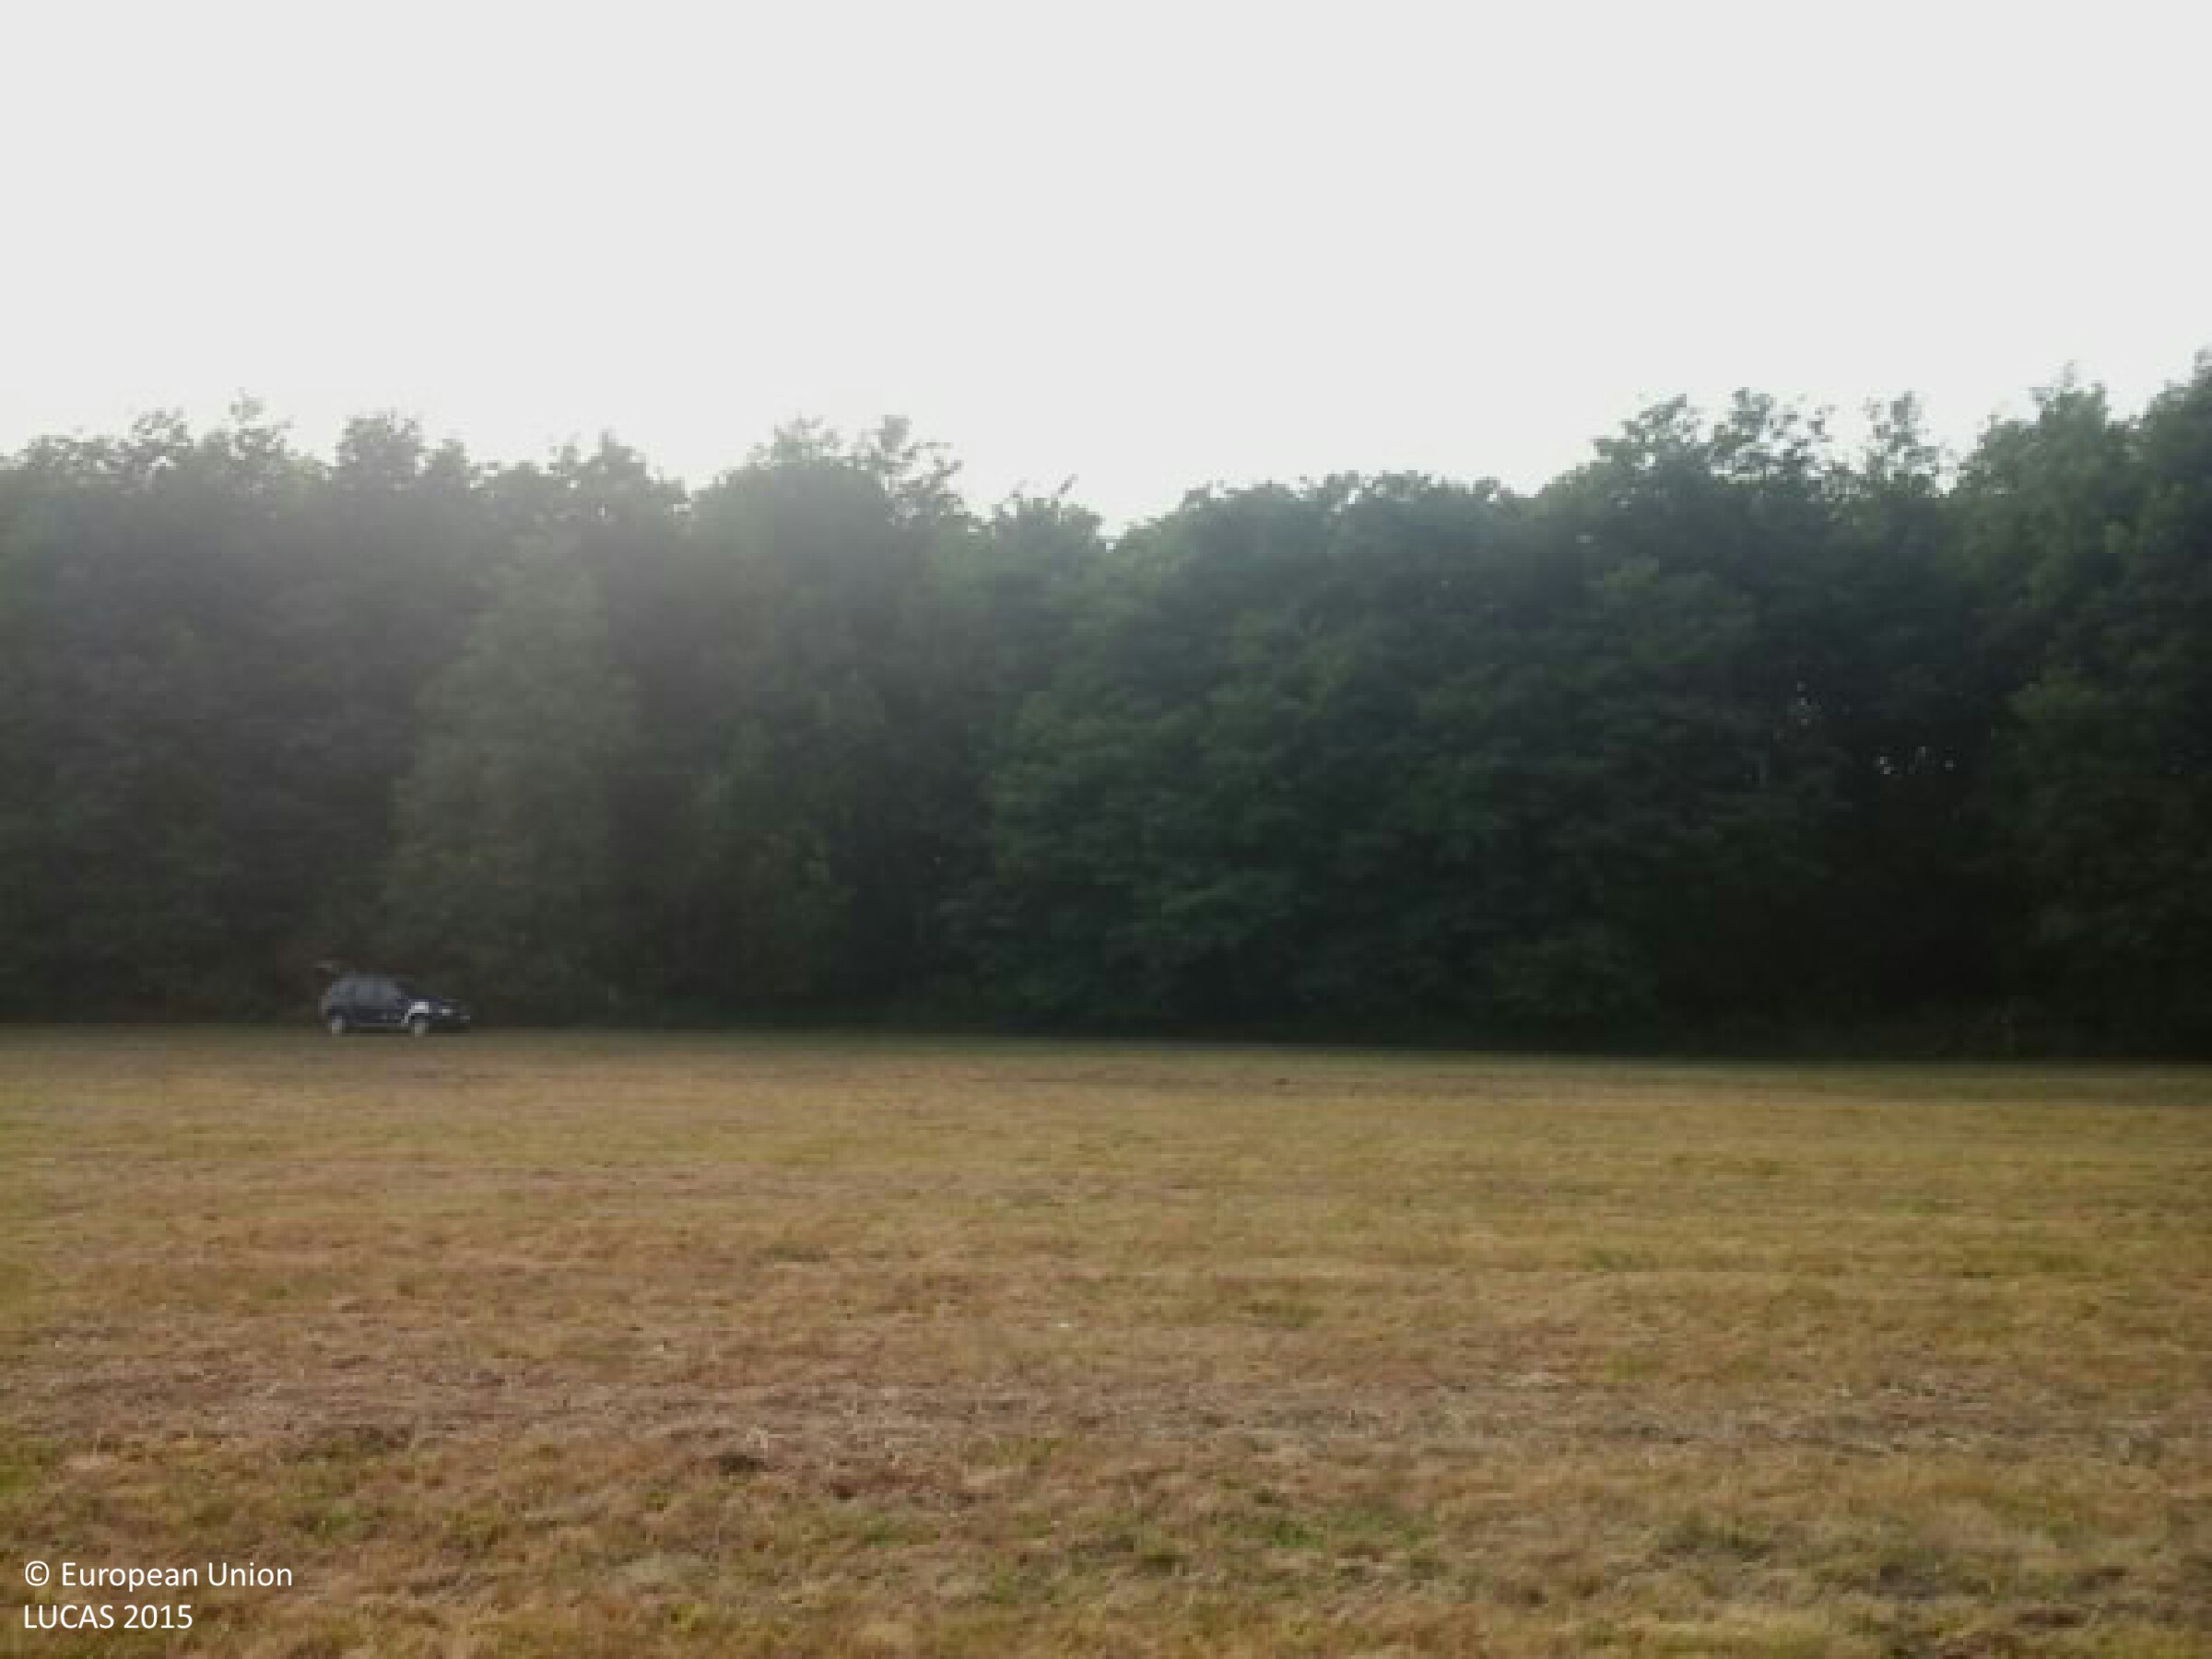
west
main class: Grassland
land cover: Grassland without tree/shrub cover
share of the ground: > 75 %
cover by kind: herbaceous plants 95 %, unconsolidated bare surface 5 %
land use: Agriculture (excluding fallow land and kitchen gardens)
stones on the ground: < 10 %
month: August
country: HU
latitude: 46.5448
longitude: 17.1631
